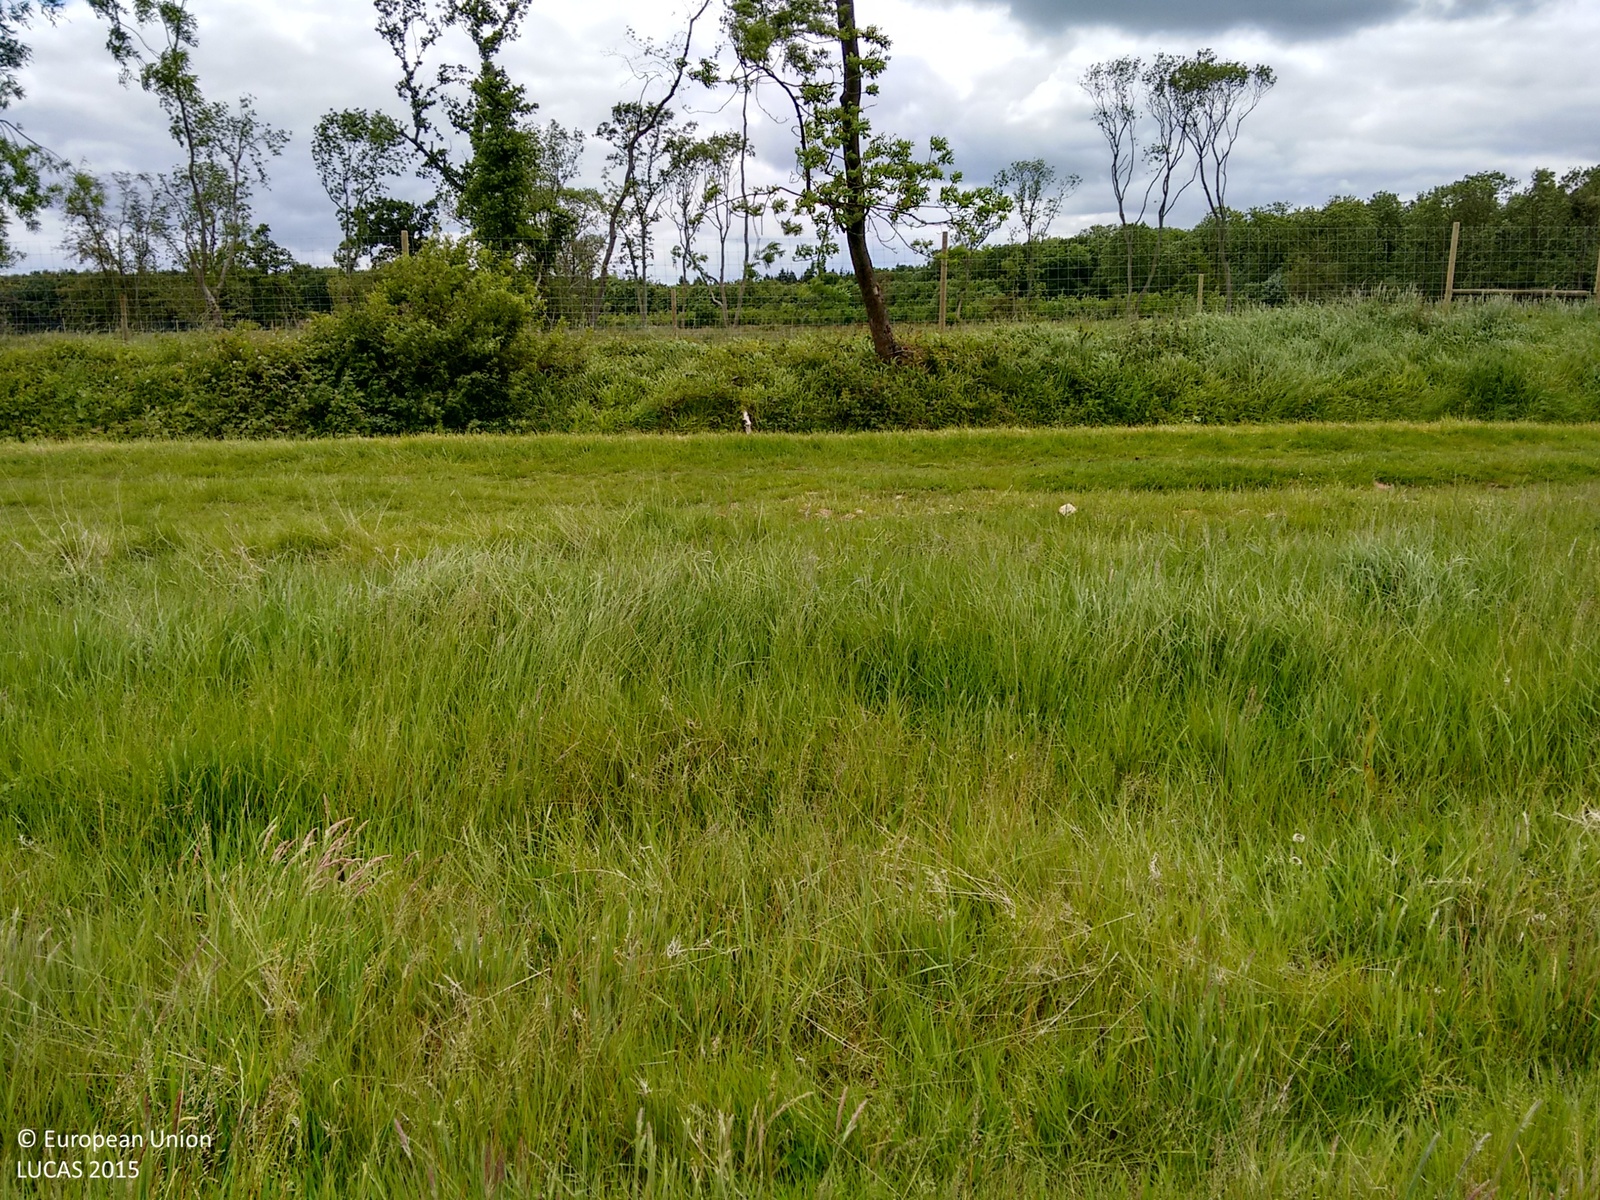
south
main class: Grassland
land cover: Grassland without tree/shrub cover
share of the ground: > 75 %
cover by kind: herbaceous plants 100 %
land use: Agriculture (excluding fallow land and kitchen gardens)
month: June
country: GB
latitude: 52.8199
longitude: -0.4692
